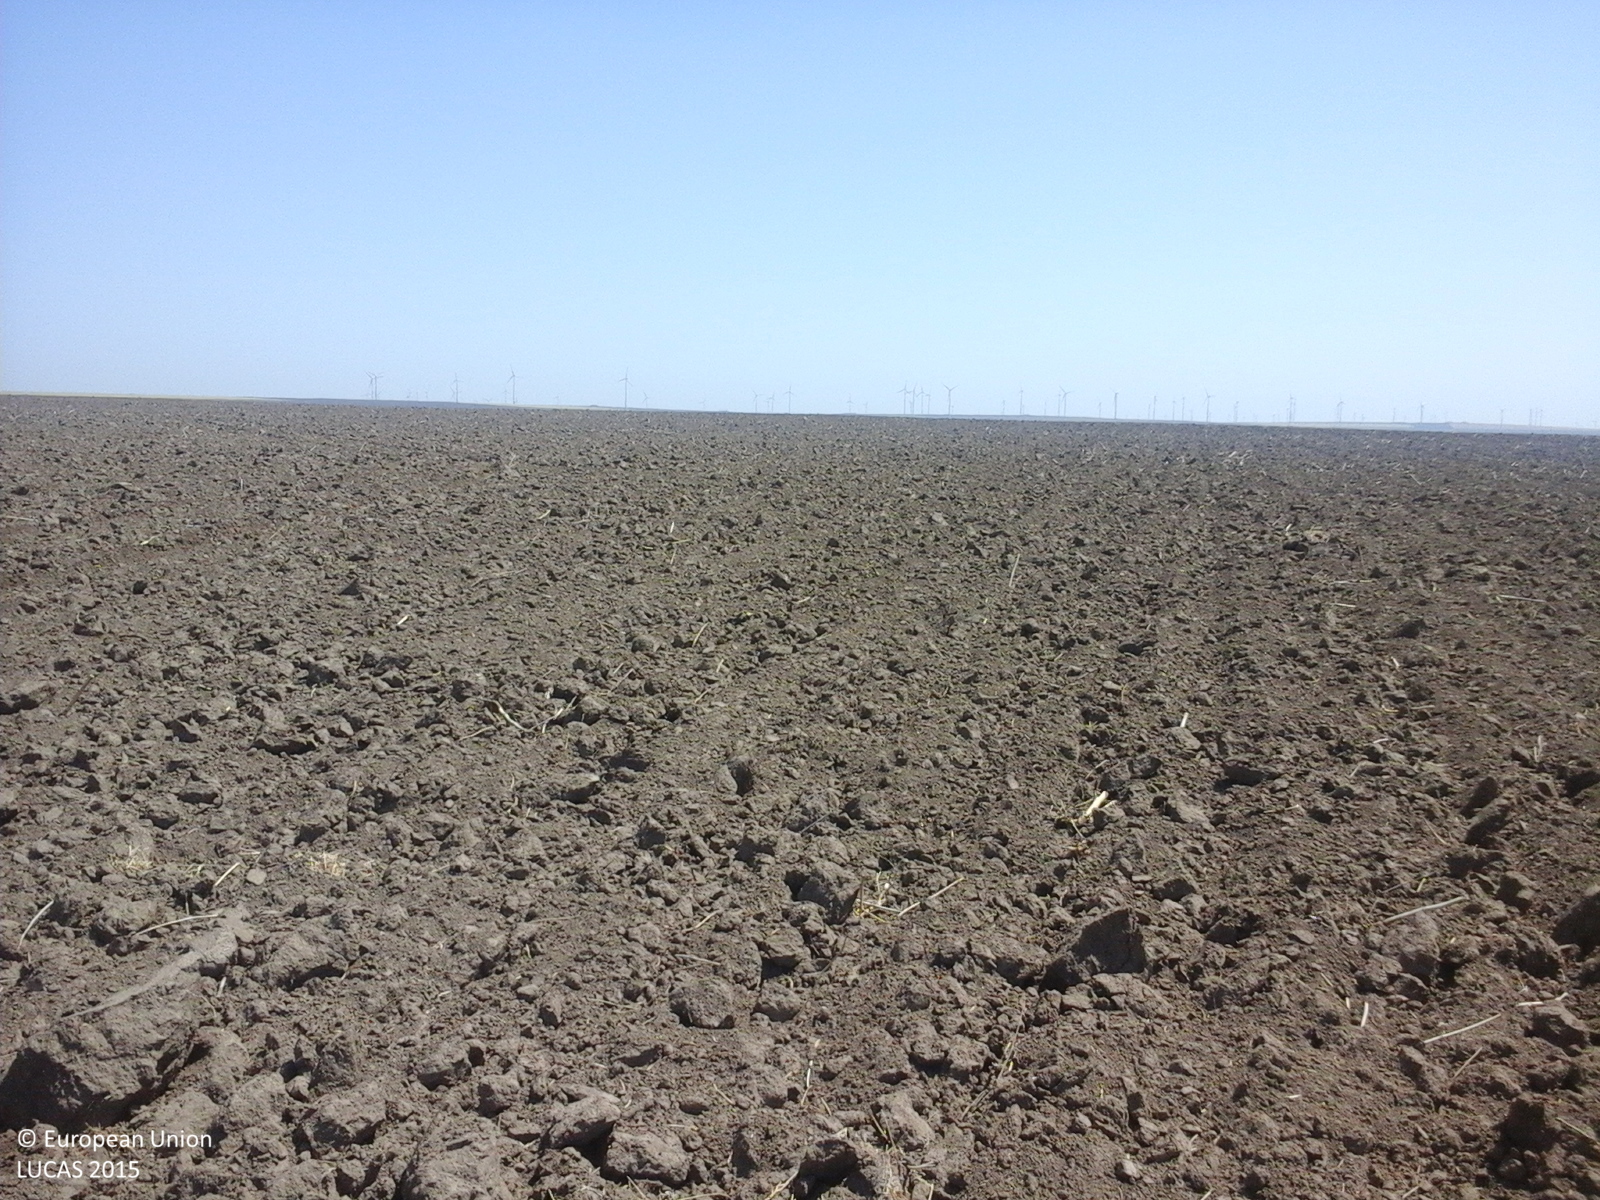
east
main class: Cropland
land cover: Rape and turnip rape
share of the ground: < 10 %
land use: Agriculture (excluding fallow land and kitchen gardens)
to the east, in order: Rape and turnip rape
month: August
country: RO
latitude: 44.5462
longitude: 28.2278
